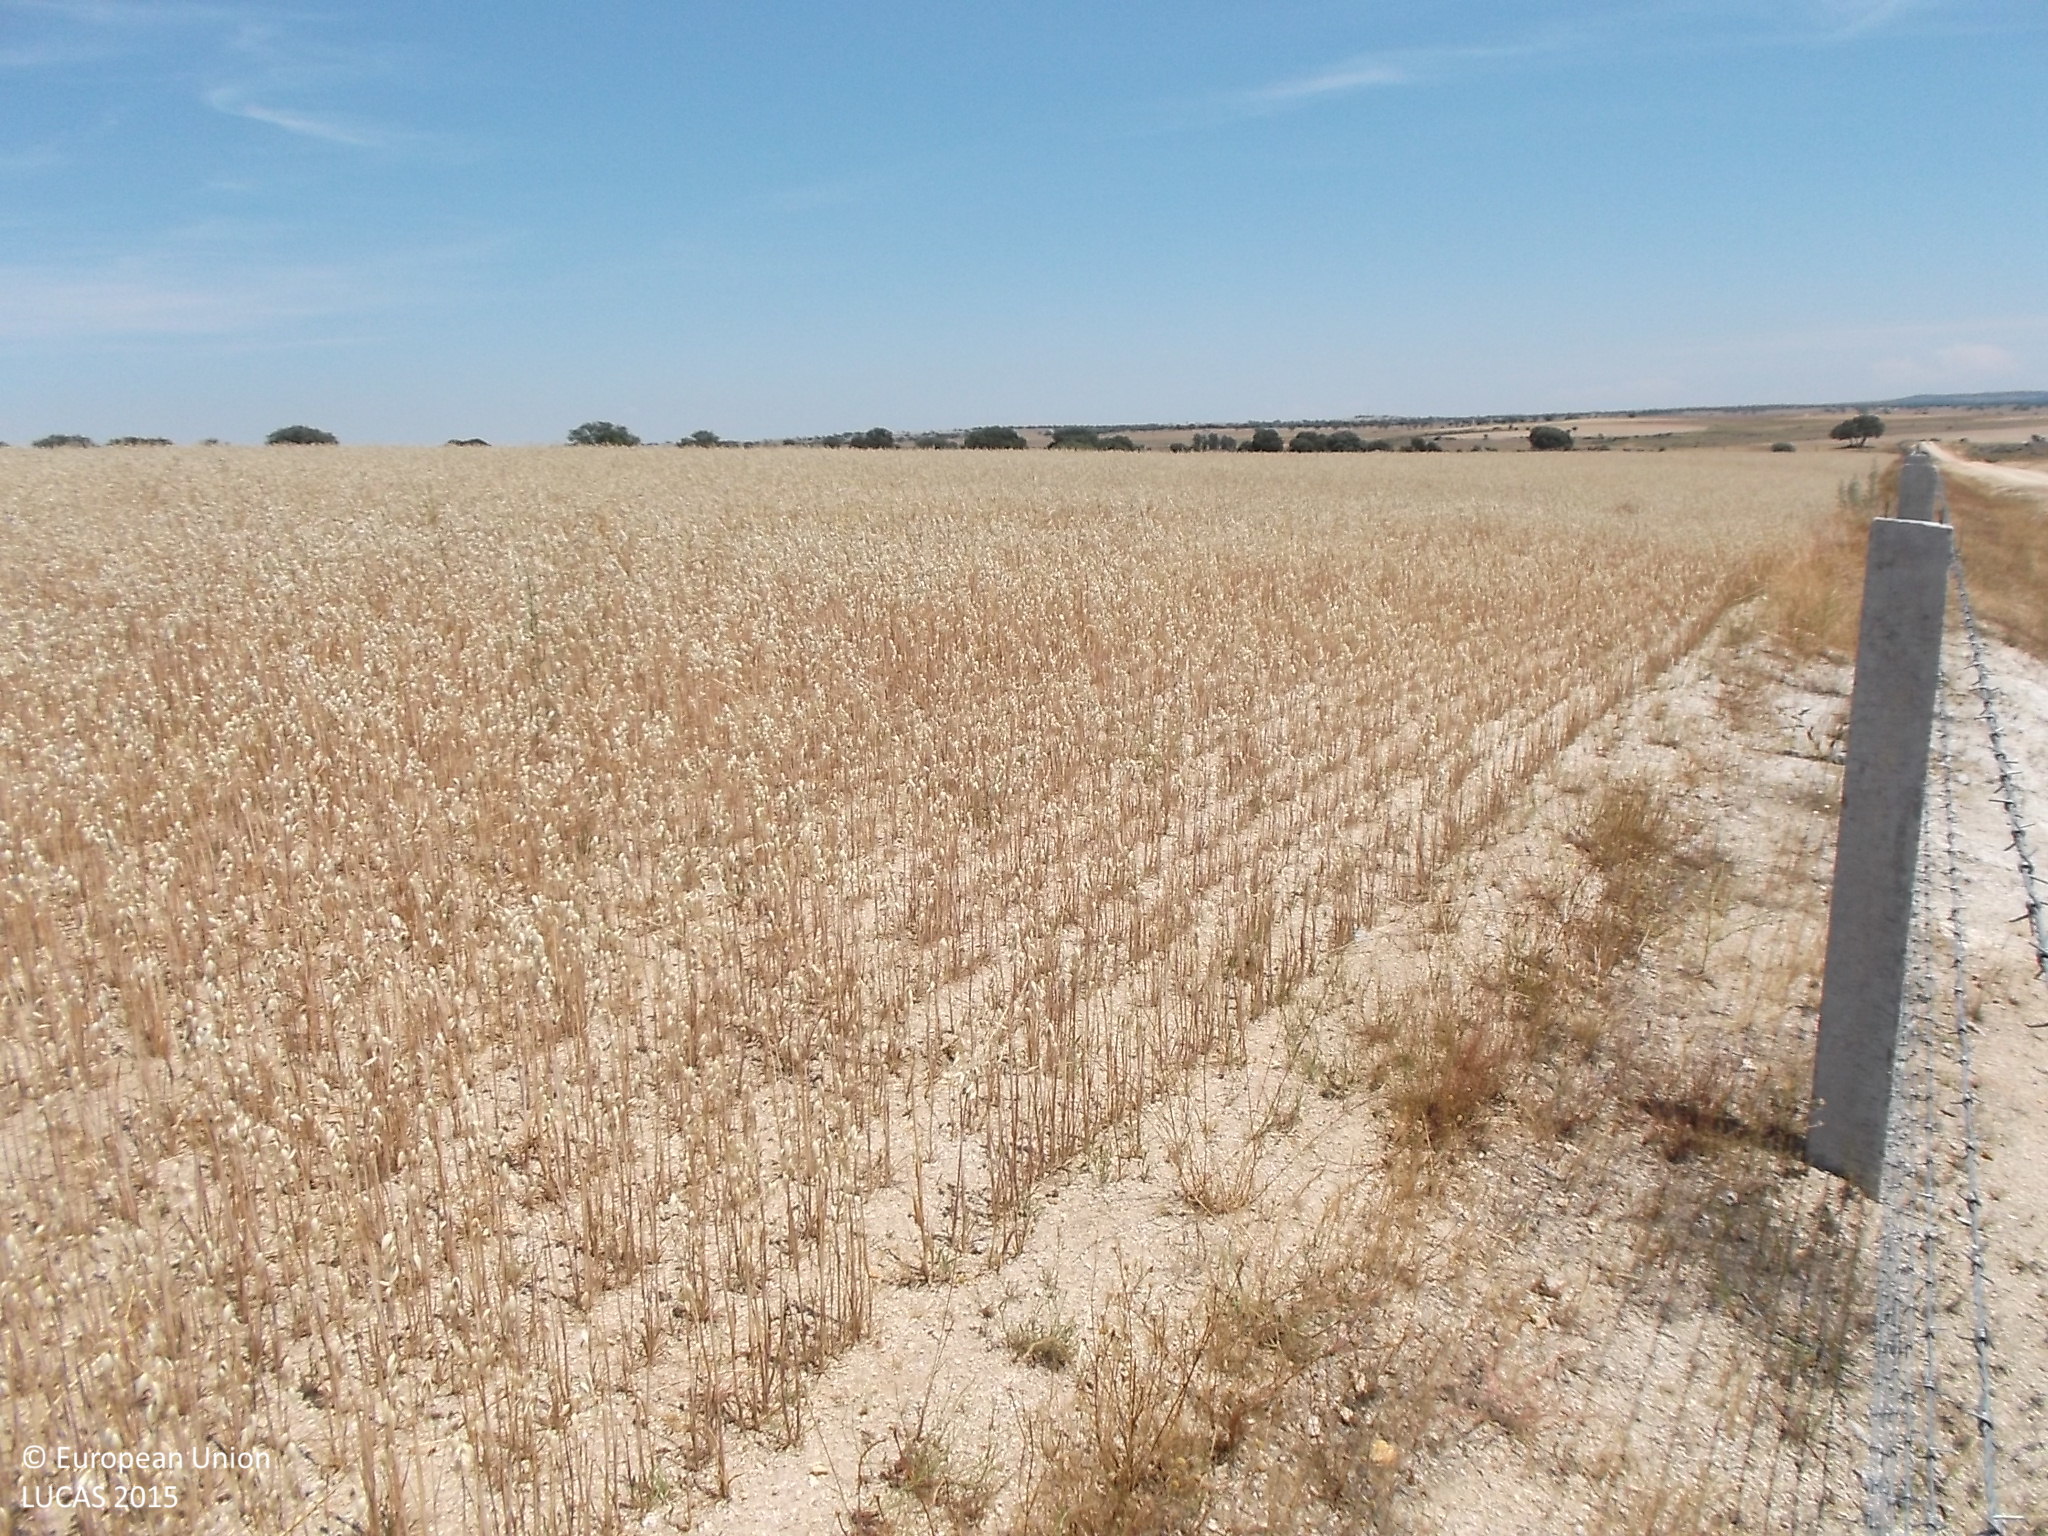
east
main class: Cropland
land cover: Oats
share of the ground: > 75 %
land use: Agriculture (excluding fallow land and kitchen gardens)
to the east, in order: Oats; Grass margins; Fences; Grassland without tree/shrub cover; Fences; Grassland without tree/shrub cover
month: June
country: ES
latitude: 41.2900
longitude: -6.0550
